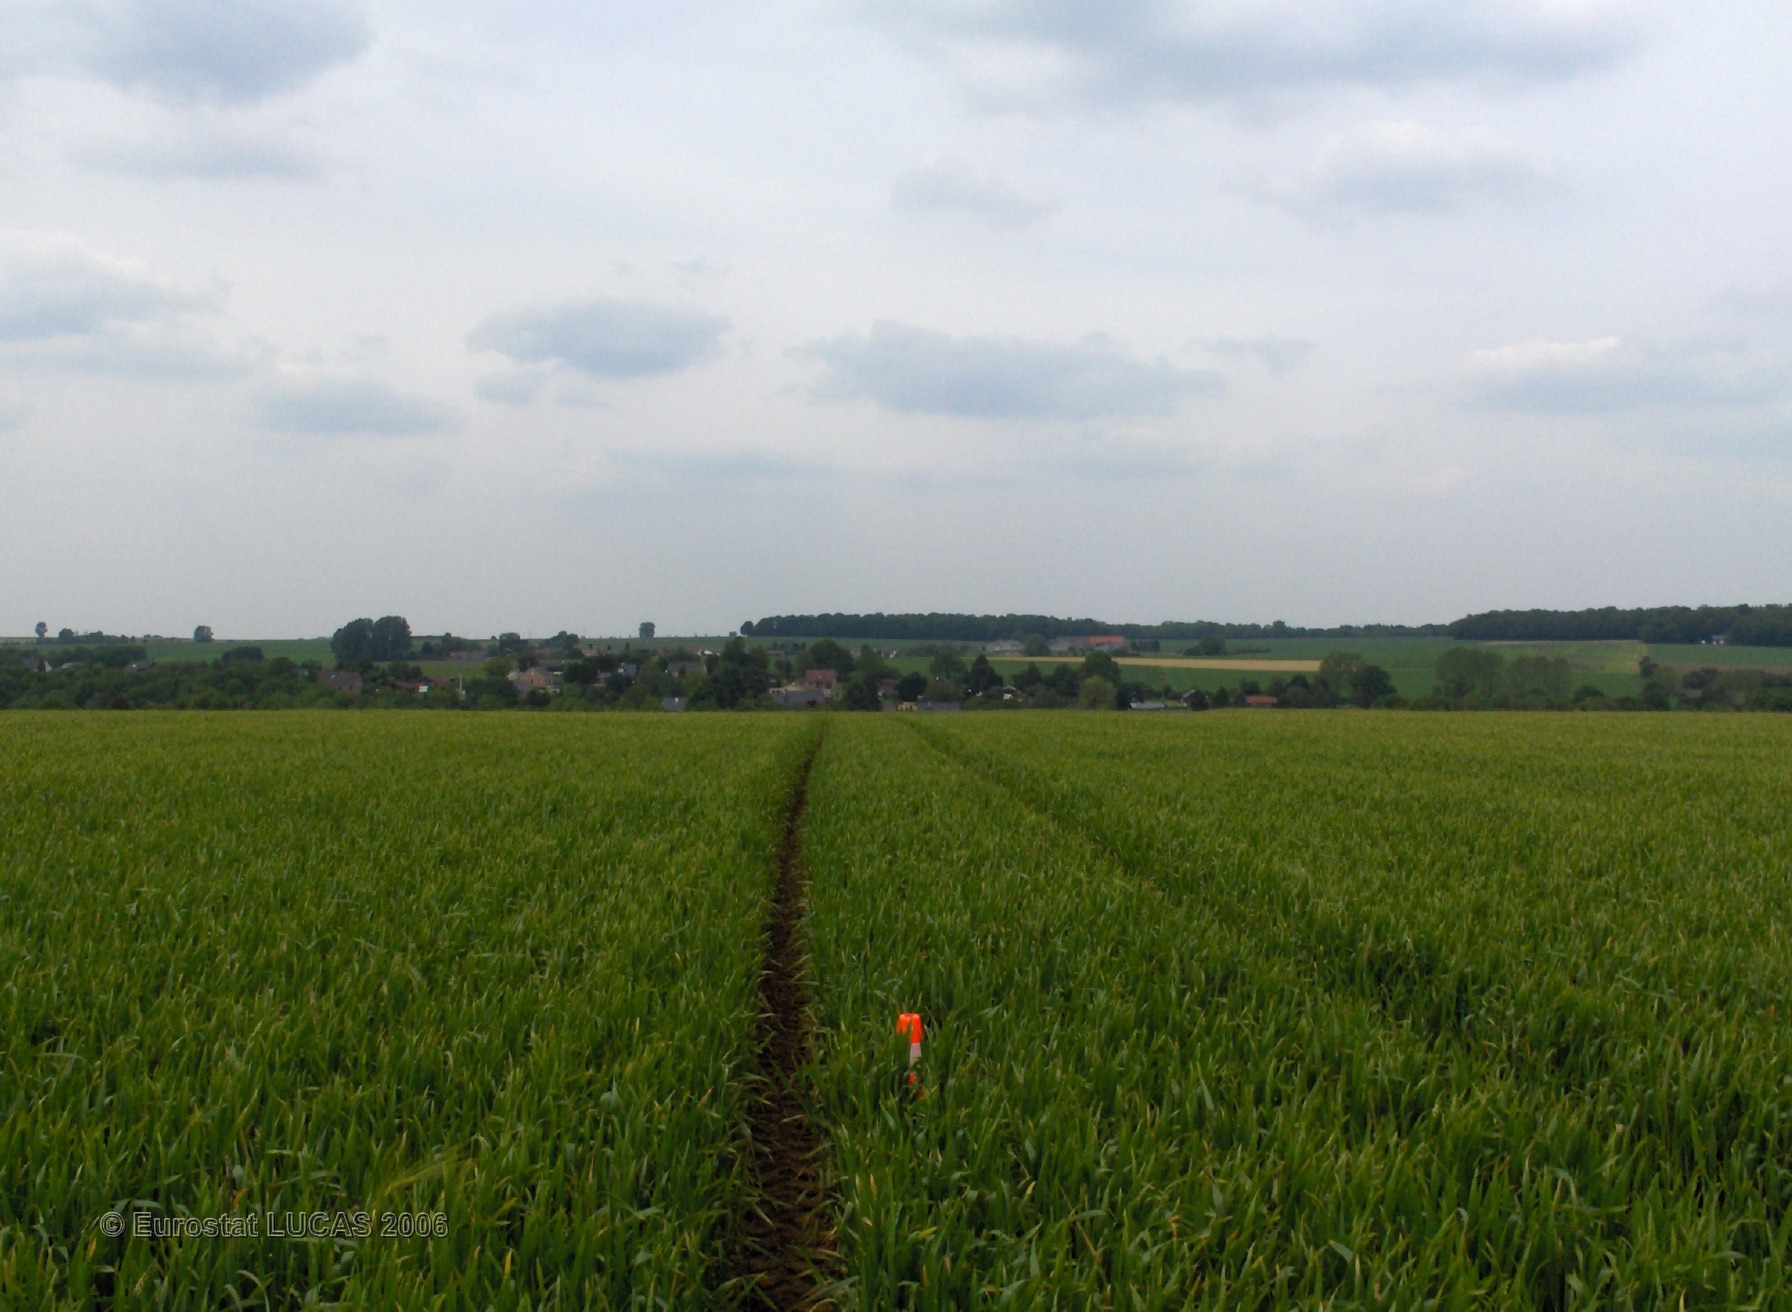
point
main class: Cropland
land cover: Common wheat
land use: Agriculture (excluding fallow land and kitchen gardens)
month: June
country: BE
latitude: 50.2338
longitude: 4.5425
